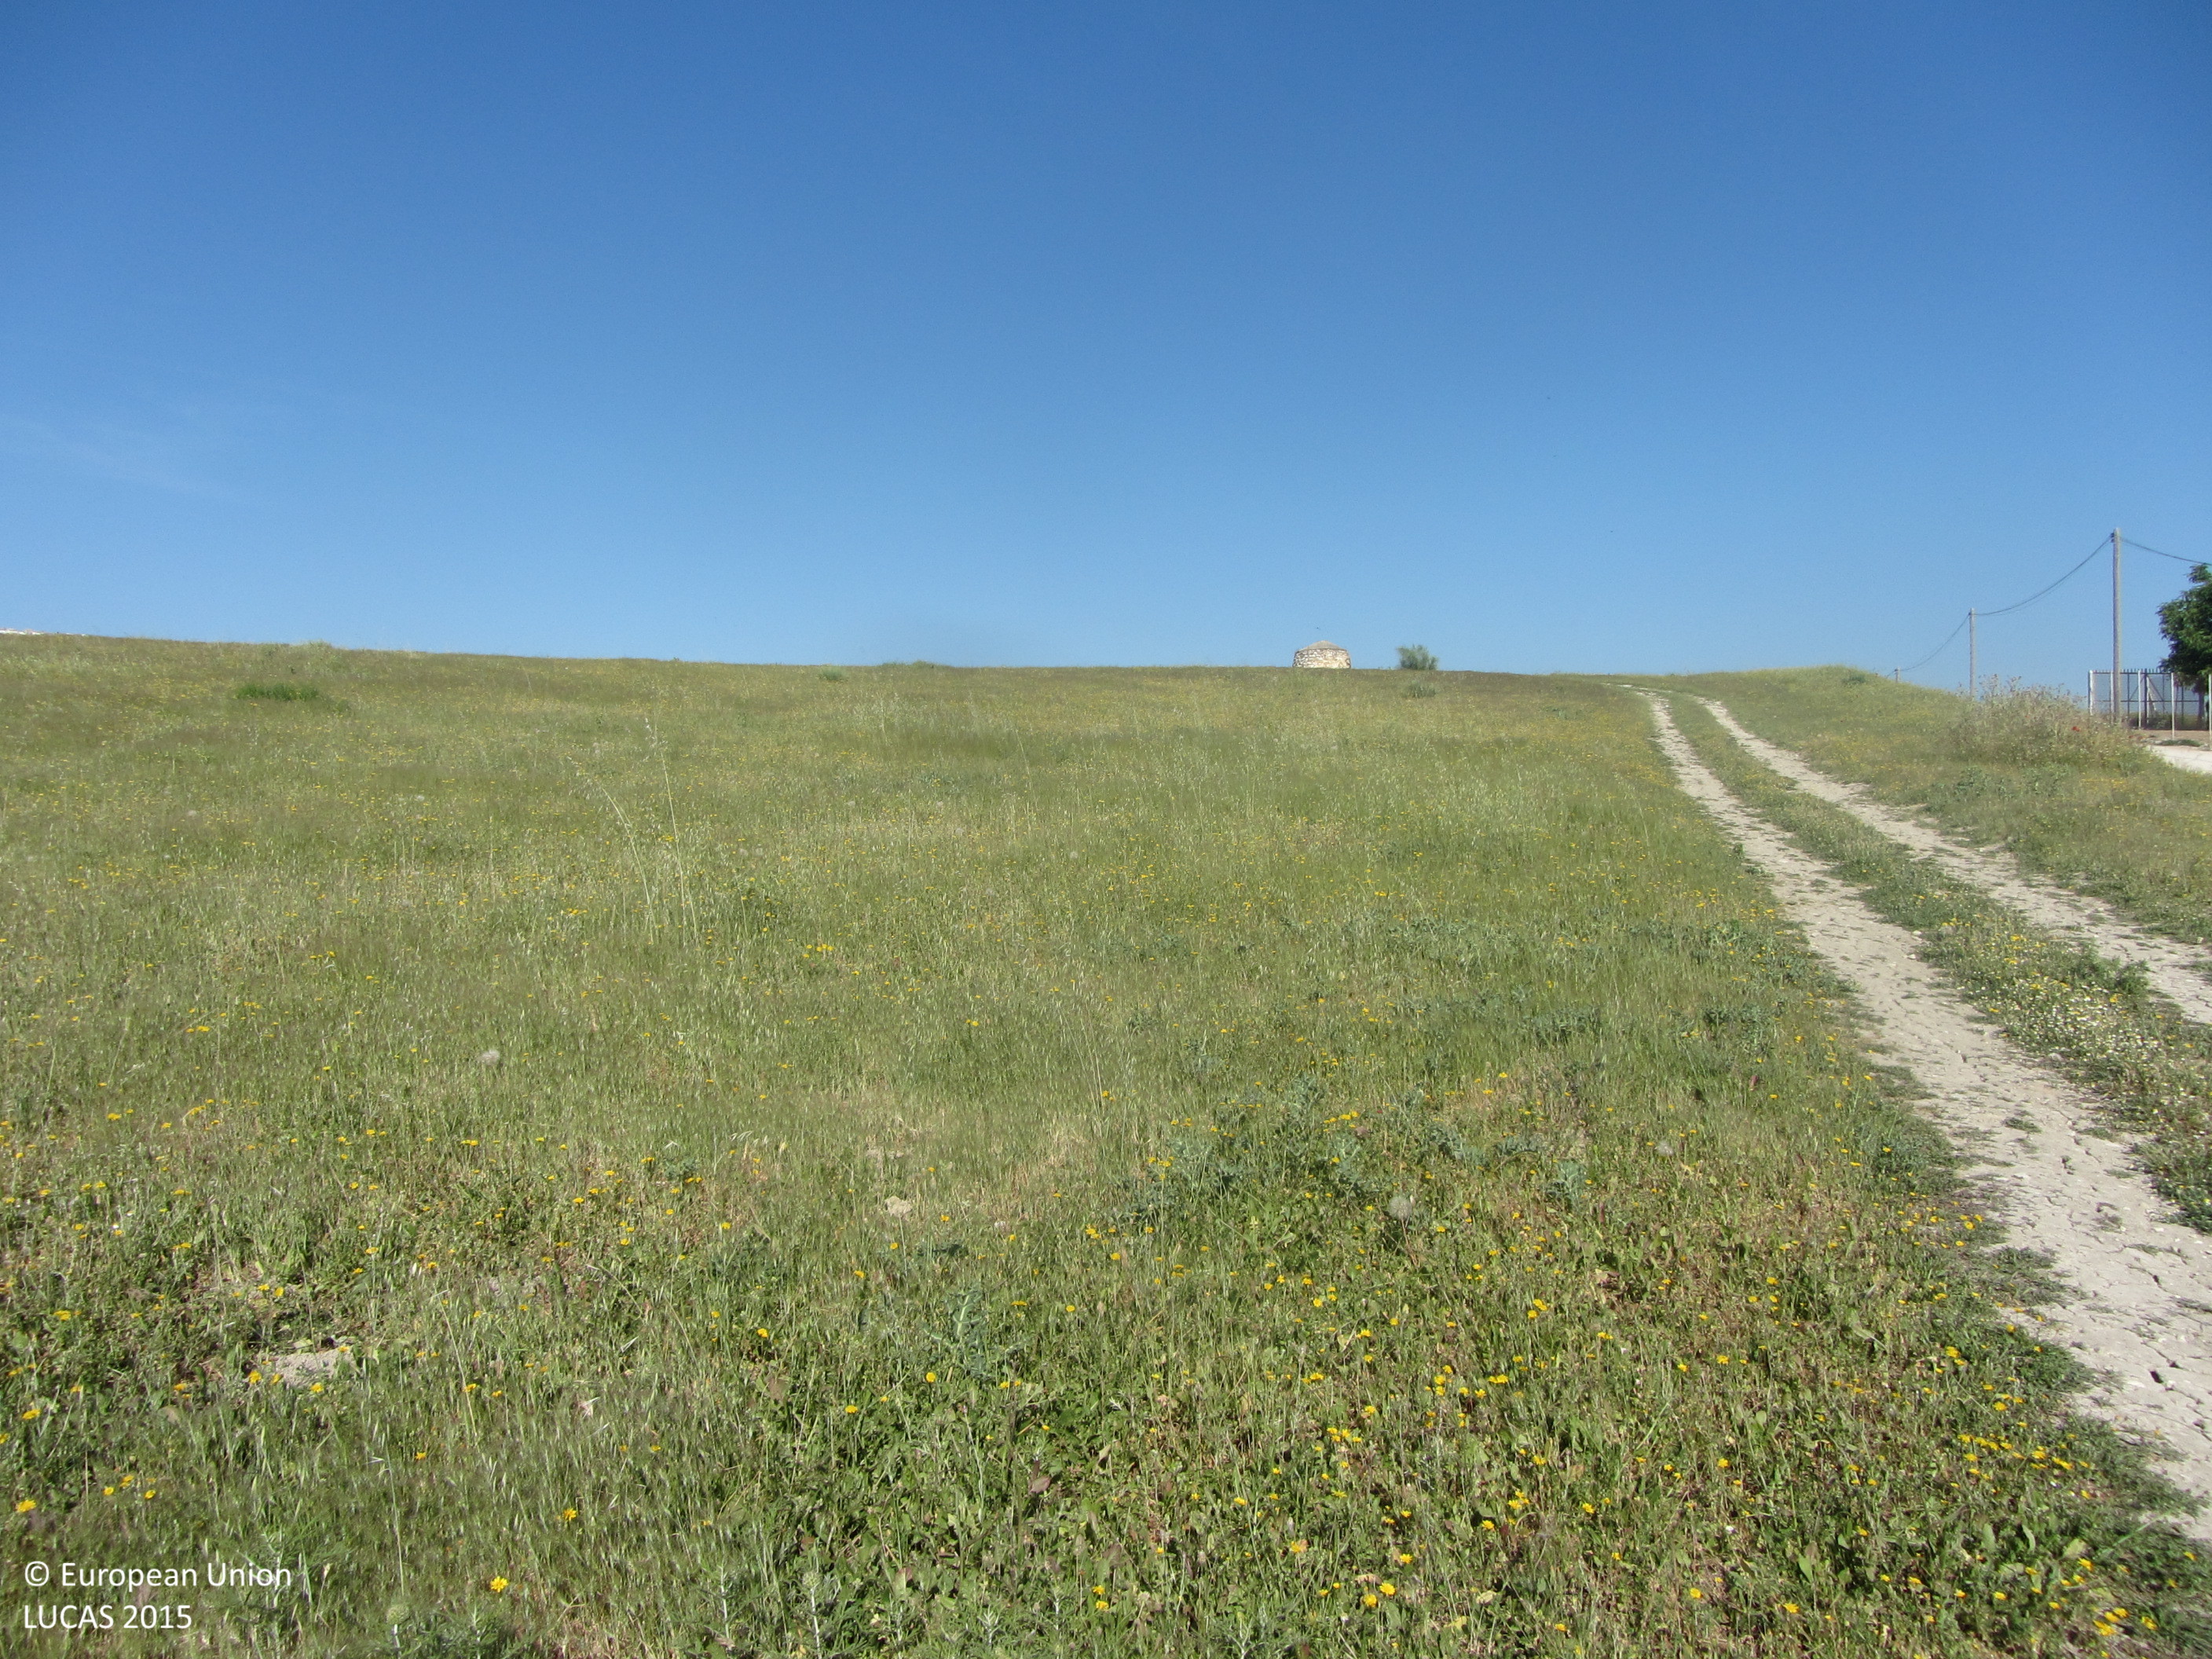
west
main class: Grassland
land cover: Grassland without tree/shrub cover
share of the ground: > 75 %
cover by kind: herbaceous plants 95 %, consolidated bare surface 5 %
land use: Semi-natural and natural areas not in use
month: May
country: ES
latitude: 38.1713
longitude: -3.0001
